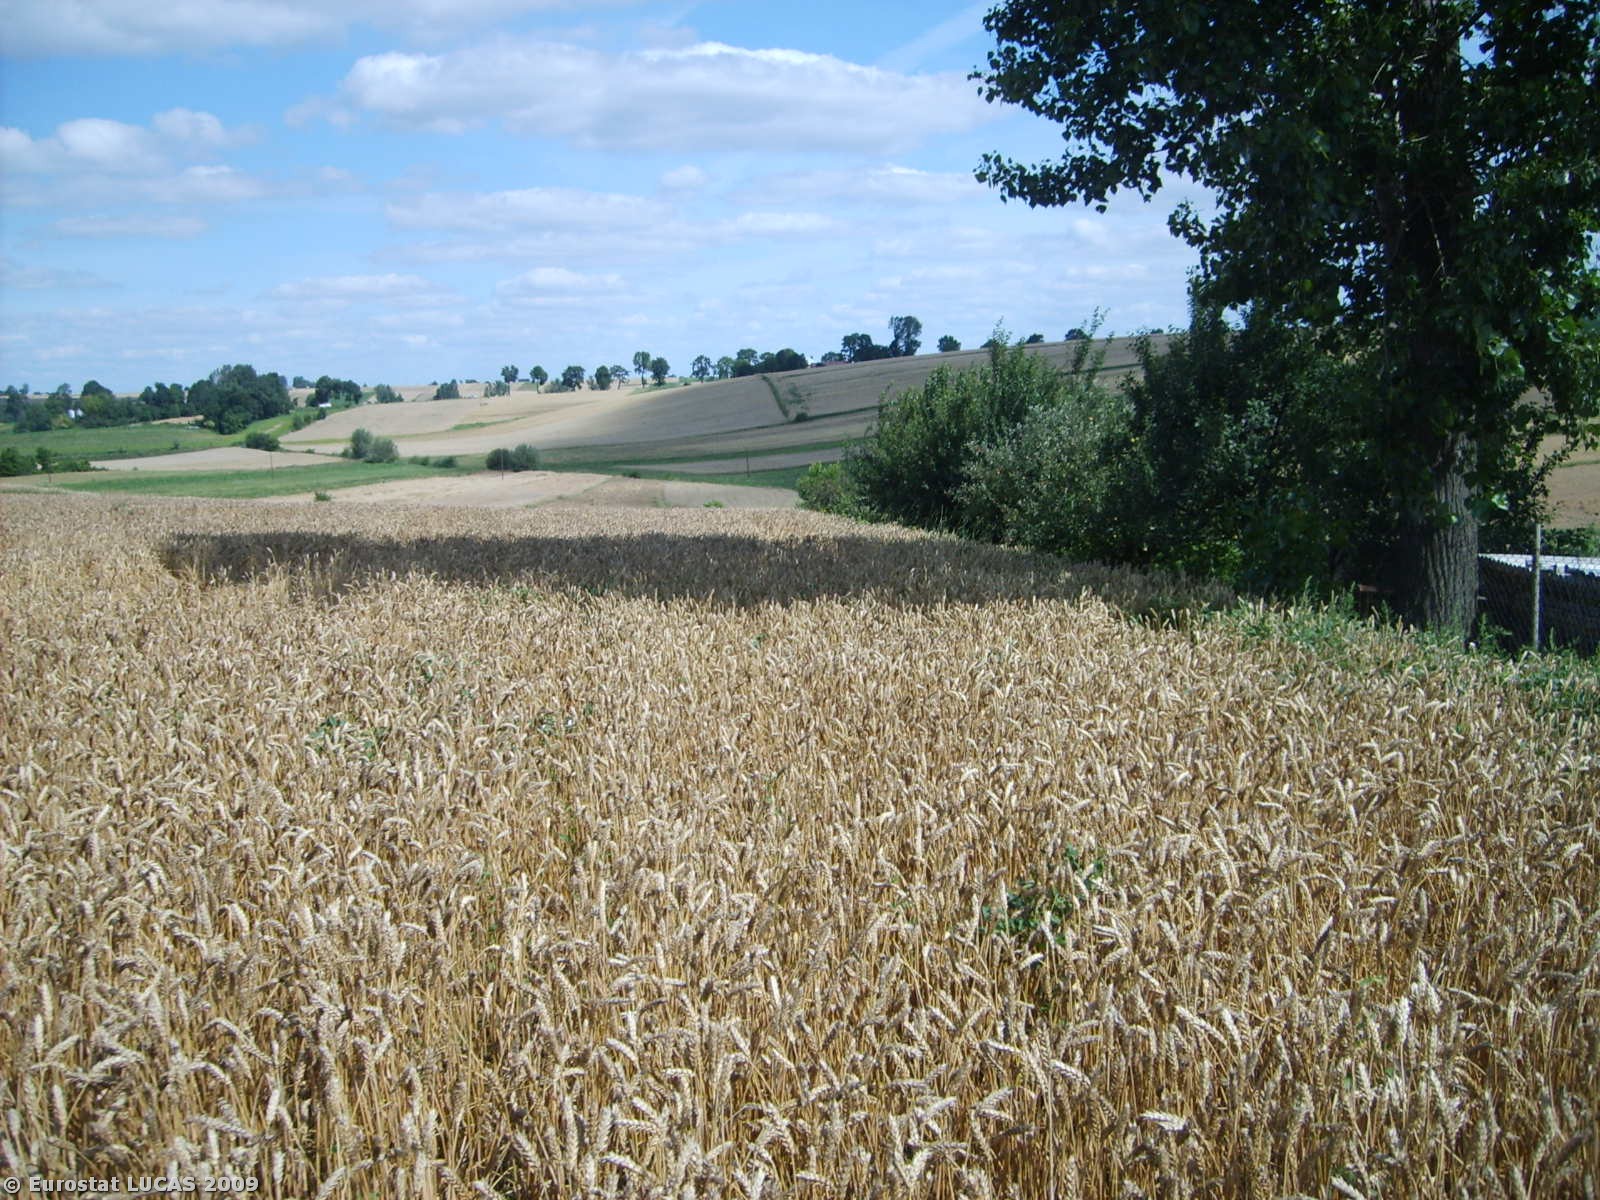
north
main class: Cropland
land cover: Common wheat
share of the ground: > 75 %
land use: Agriculture (excluding fallow land and kitchen gardens)
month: July
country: PL
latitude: 50.3172
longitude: 20.2734
